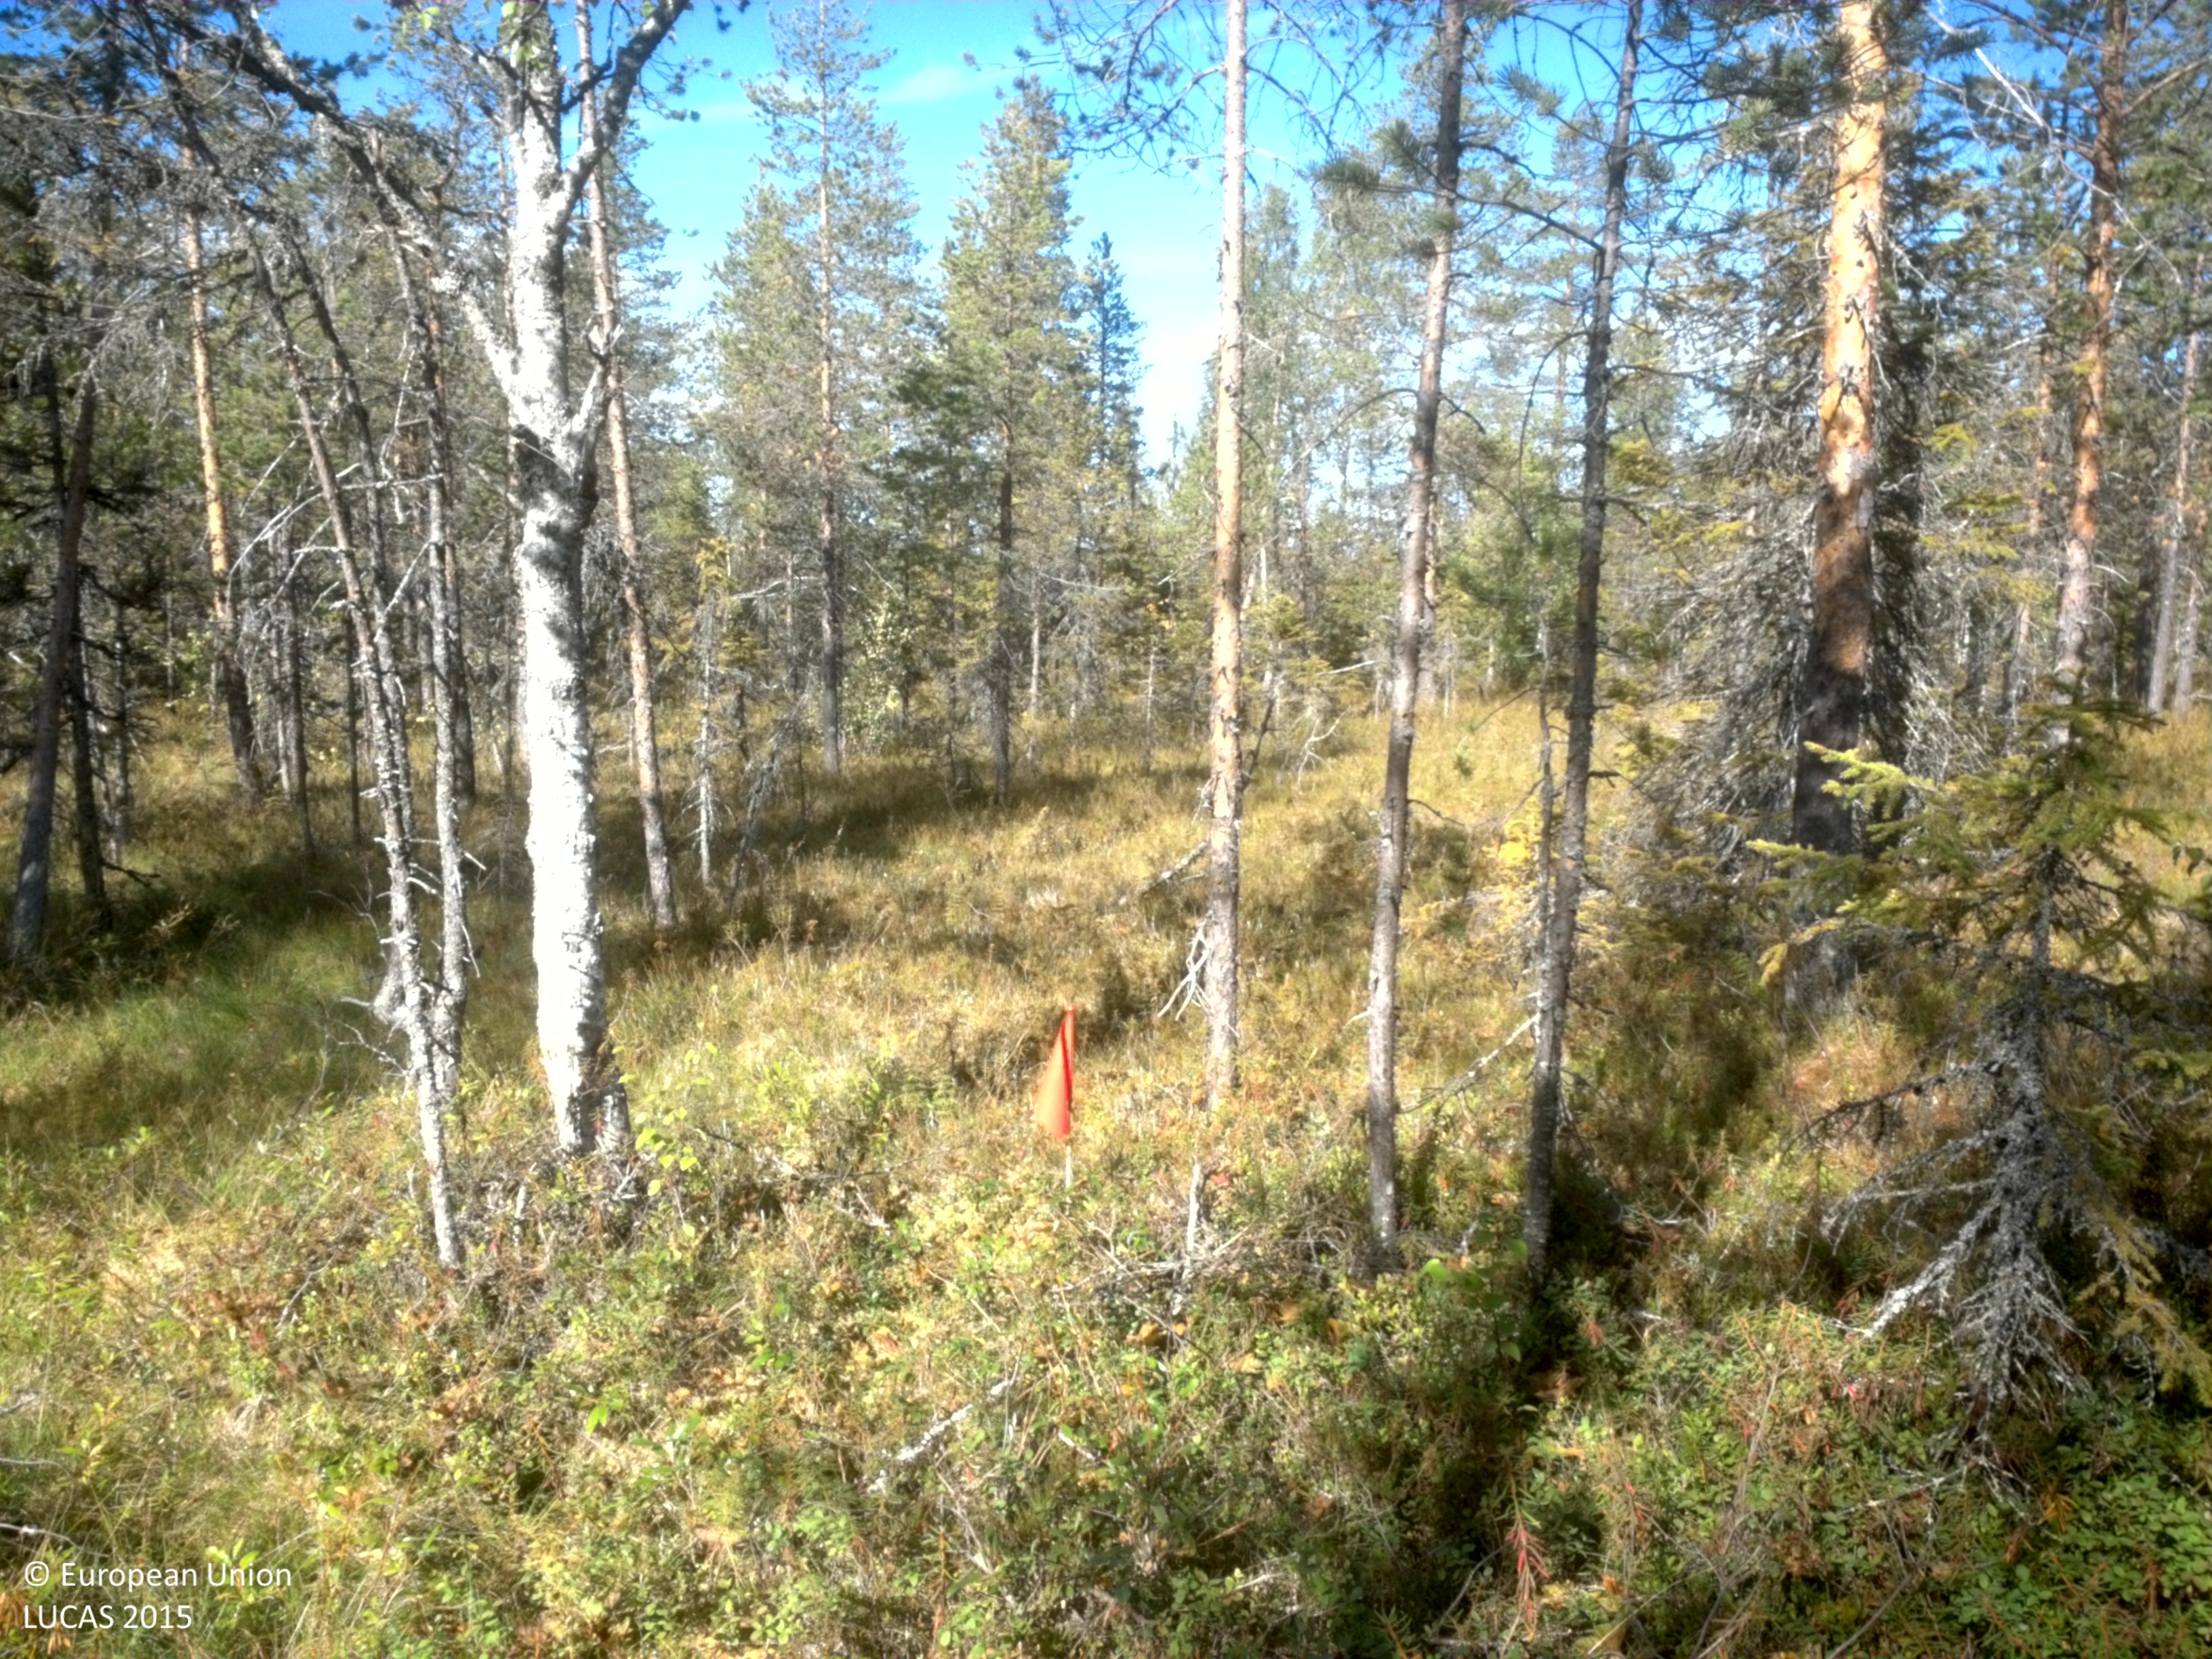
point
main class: Woodland
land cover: Pine dominated coniferous woodland
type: boreal forest
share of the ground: 50 - 75 %
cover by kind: coniferous forest trees 55 %, shrubs 20 %, lichens and mosses 15 %, herbaceous plants 10 %
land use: Forestry
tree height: > 5 m
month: September
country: SE
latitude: 64.5715
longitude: 19.1328
